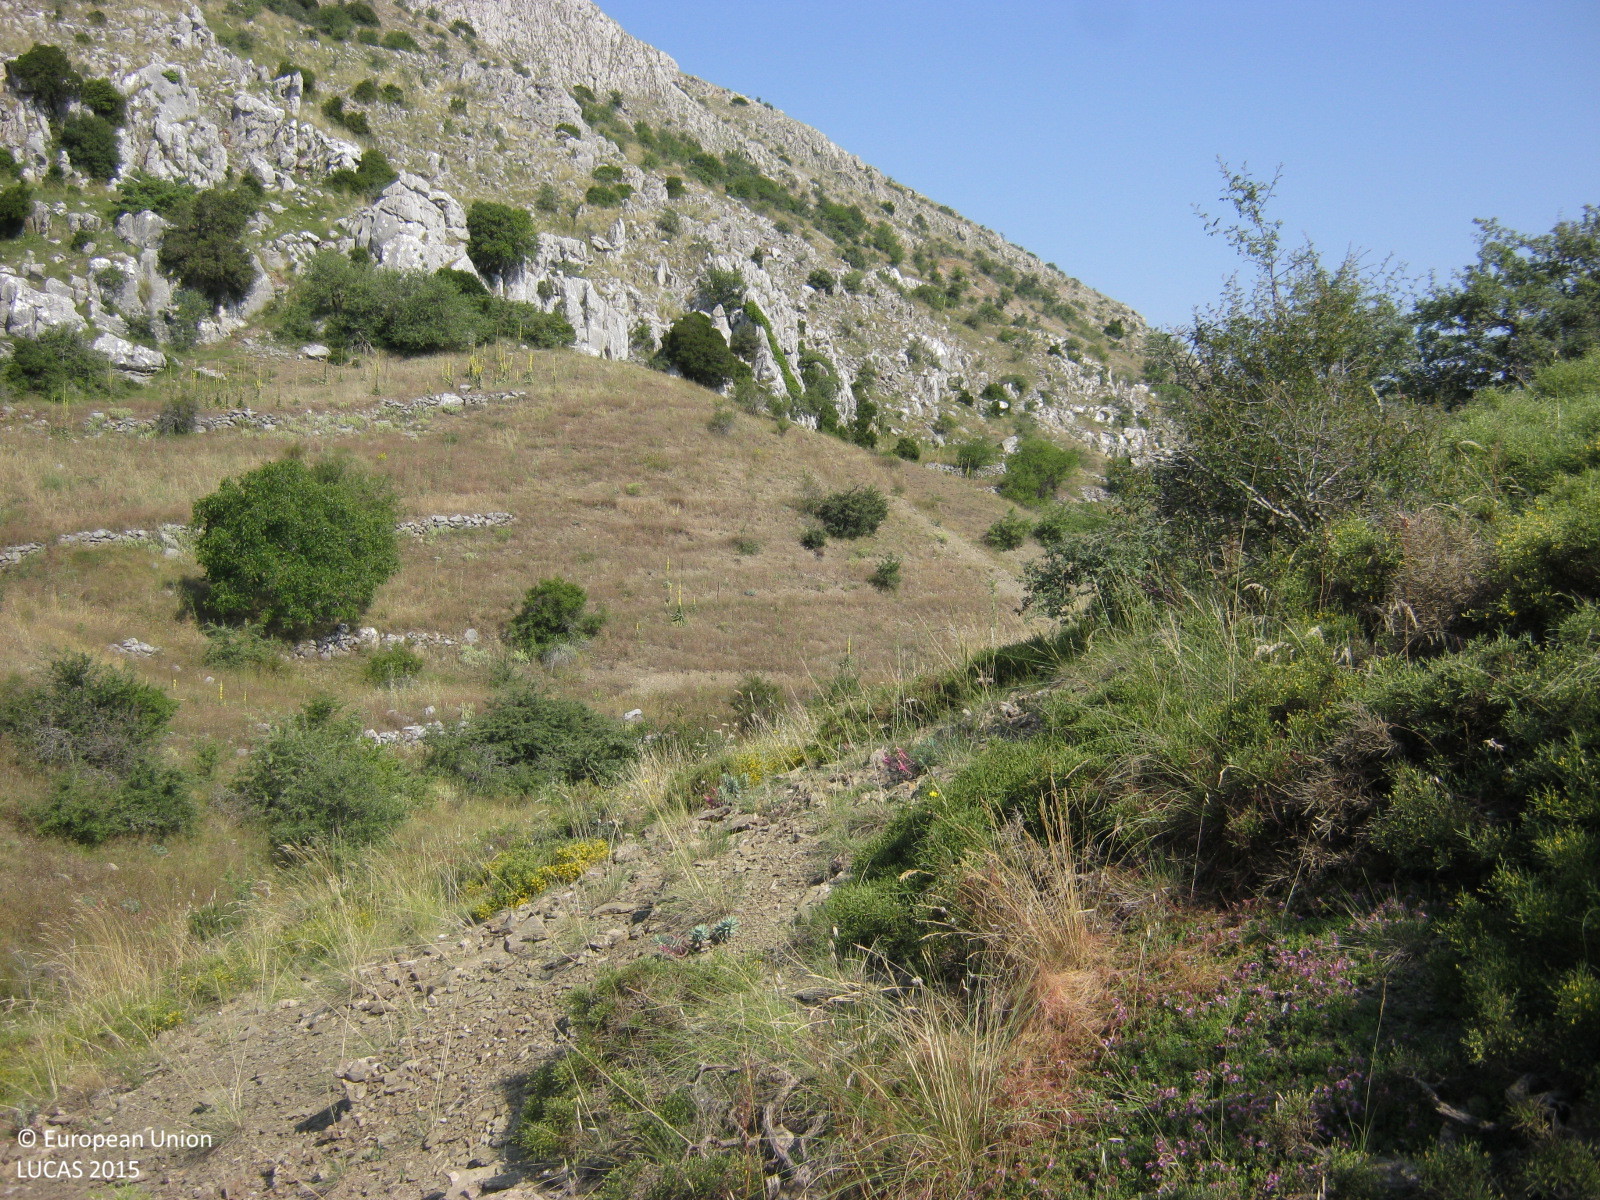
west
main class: Shrubland
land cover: Shrubland without tree cover
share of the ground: 50 - 75 %
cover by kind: shrubs 55 %, unconsolidated bare surface 25 %, herbaceous plants 20 %
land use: Semi-natural and natural areas not in use
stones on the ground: > 50 %
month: July
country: GR
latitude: 37.3616
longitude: 22.4819
